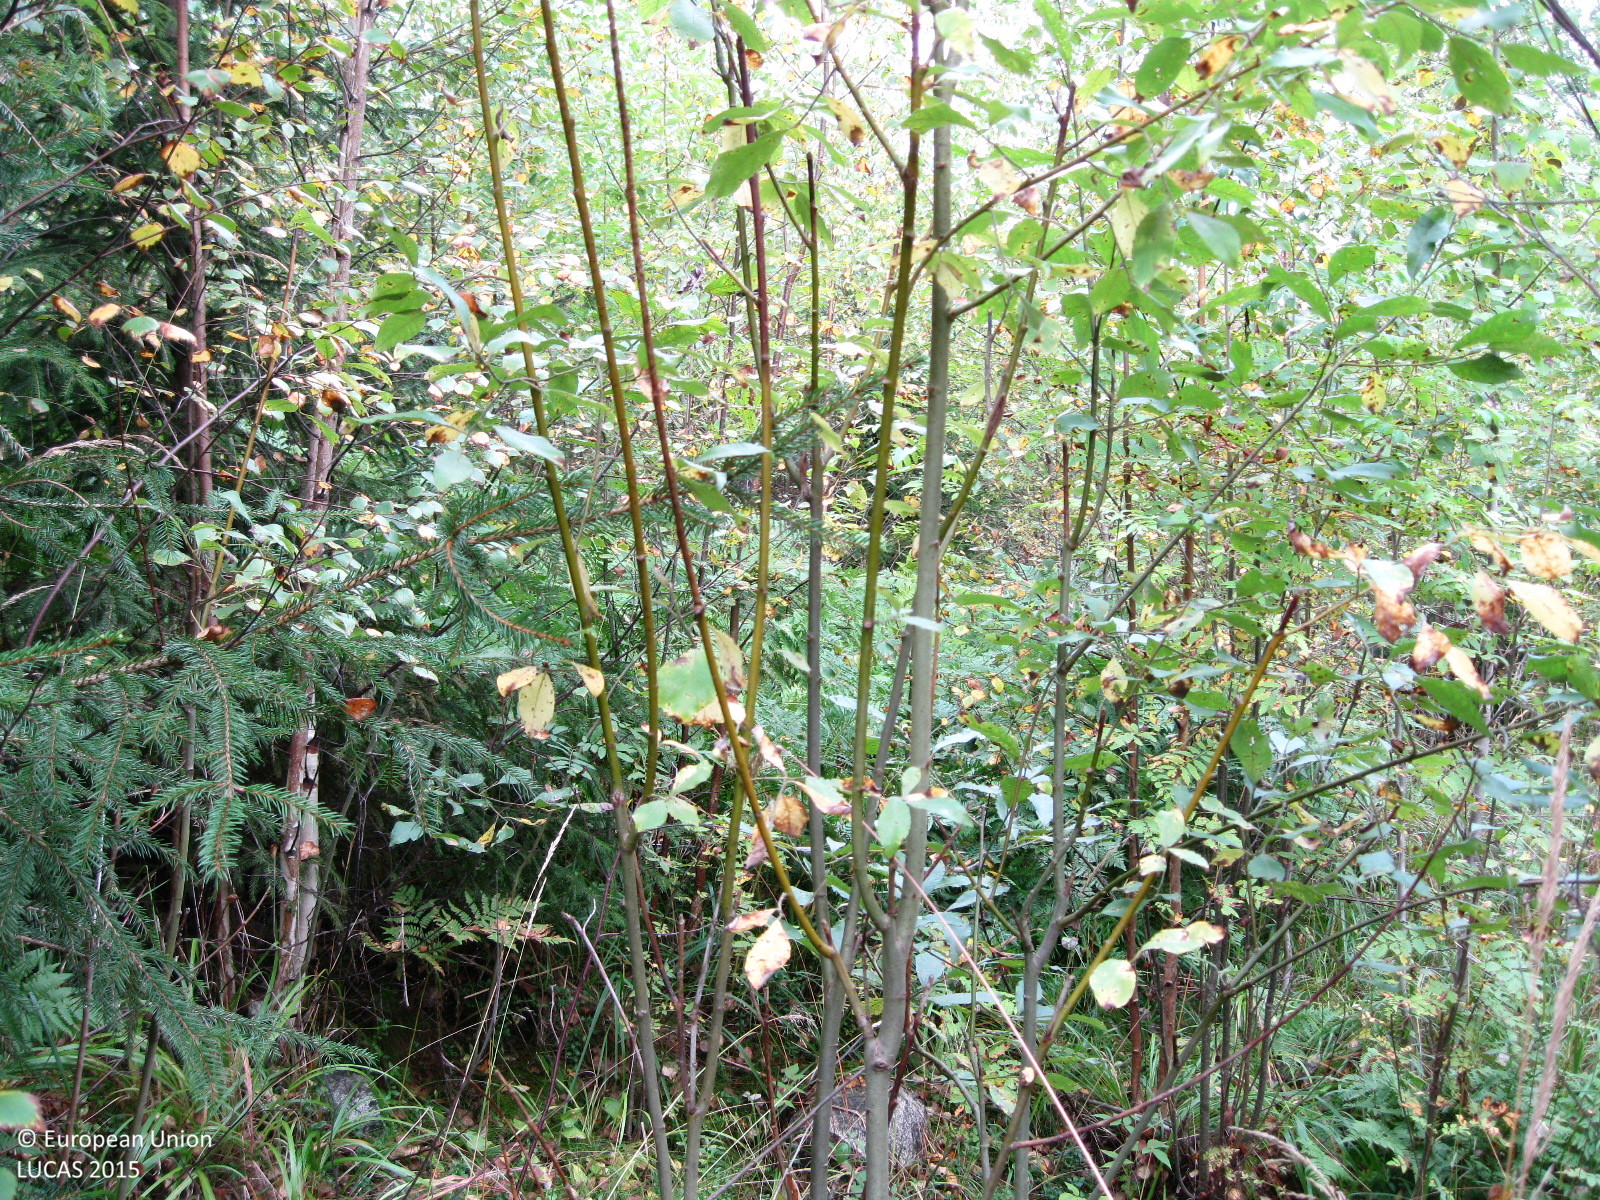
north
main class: Woodland
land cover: Broadleaved woodland
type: boreal forest
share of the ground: > 75 %
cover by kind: broadleaved forest trees 80 %, herbaceous plants 10 %, coniferous forest trees 5 %, shrubs 5 %
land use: Forestry
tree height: > 5 m
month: September
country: FI
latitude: 60.7973
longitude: 24.9040
